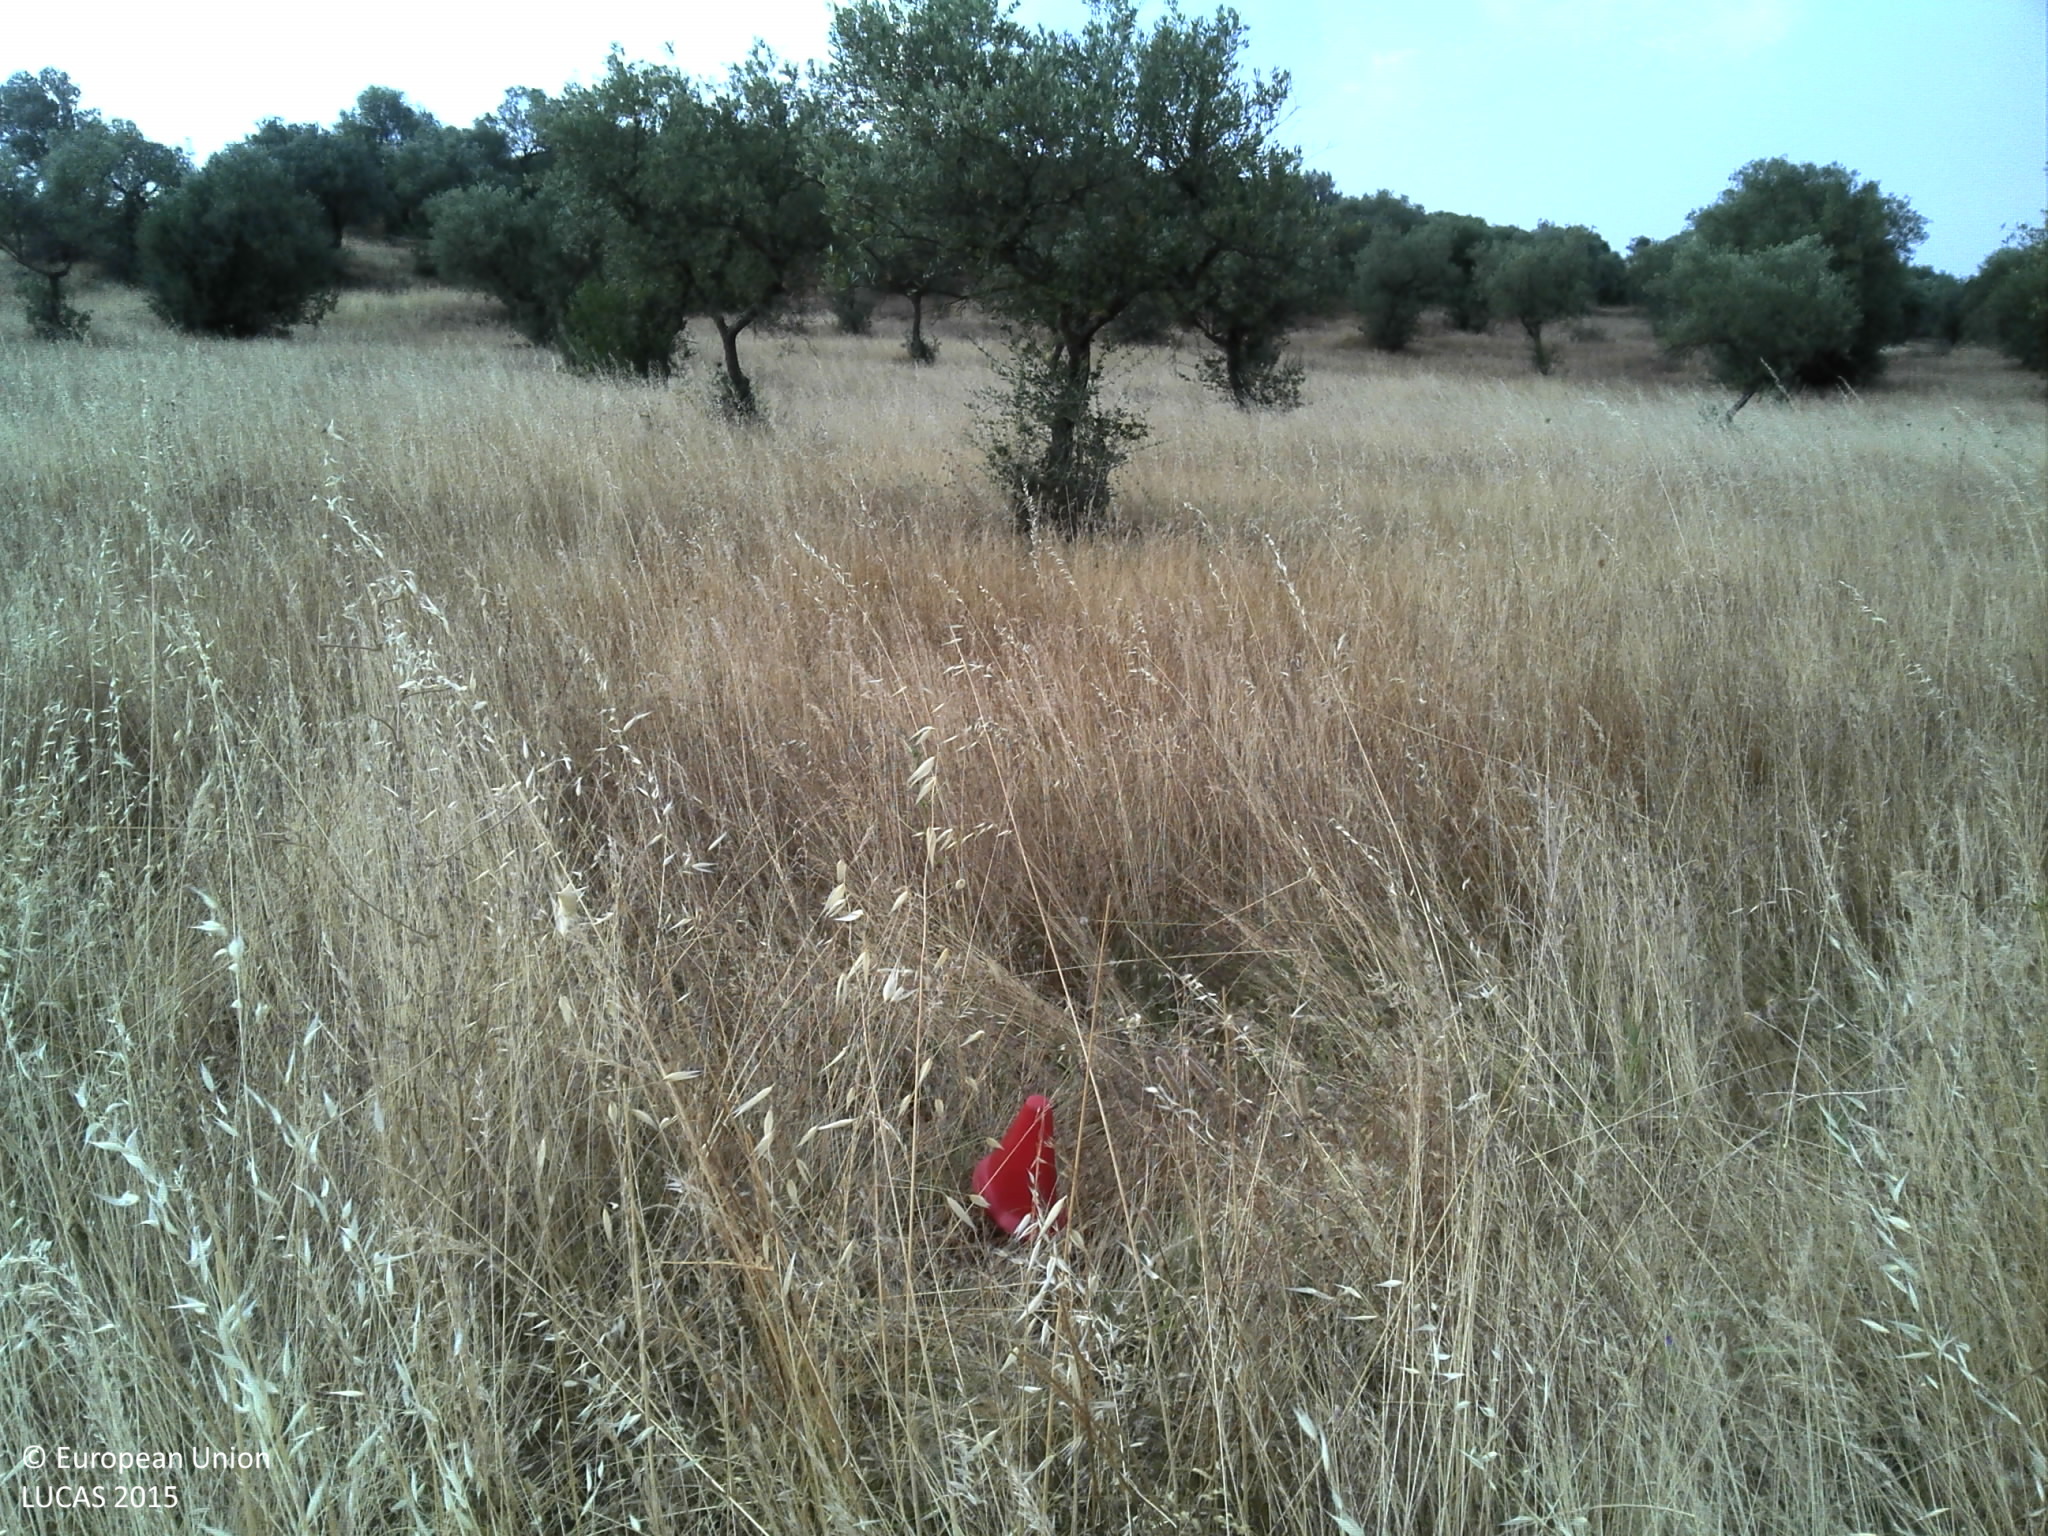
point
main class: Cropland
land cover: Olive groves
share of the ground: 25 - 50 %
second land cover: Grassland without tree/shrub cover
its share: > 75 %
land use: Agriculture (excluding fallow land and kitchen gardens)
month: June
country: PT
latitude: 37.8968
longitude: -7.5423
